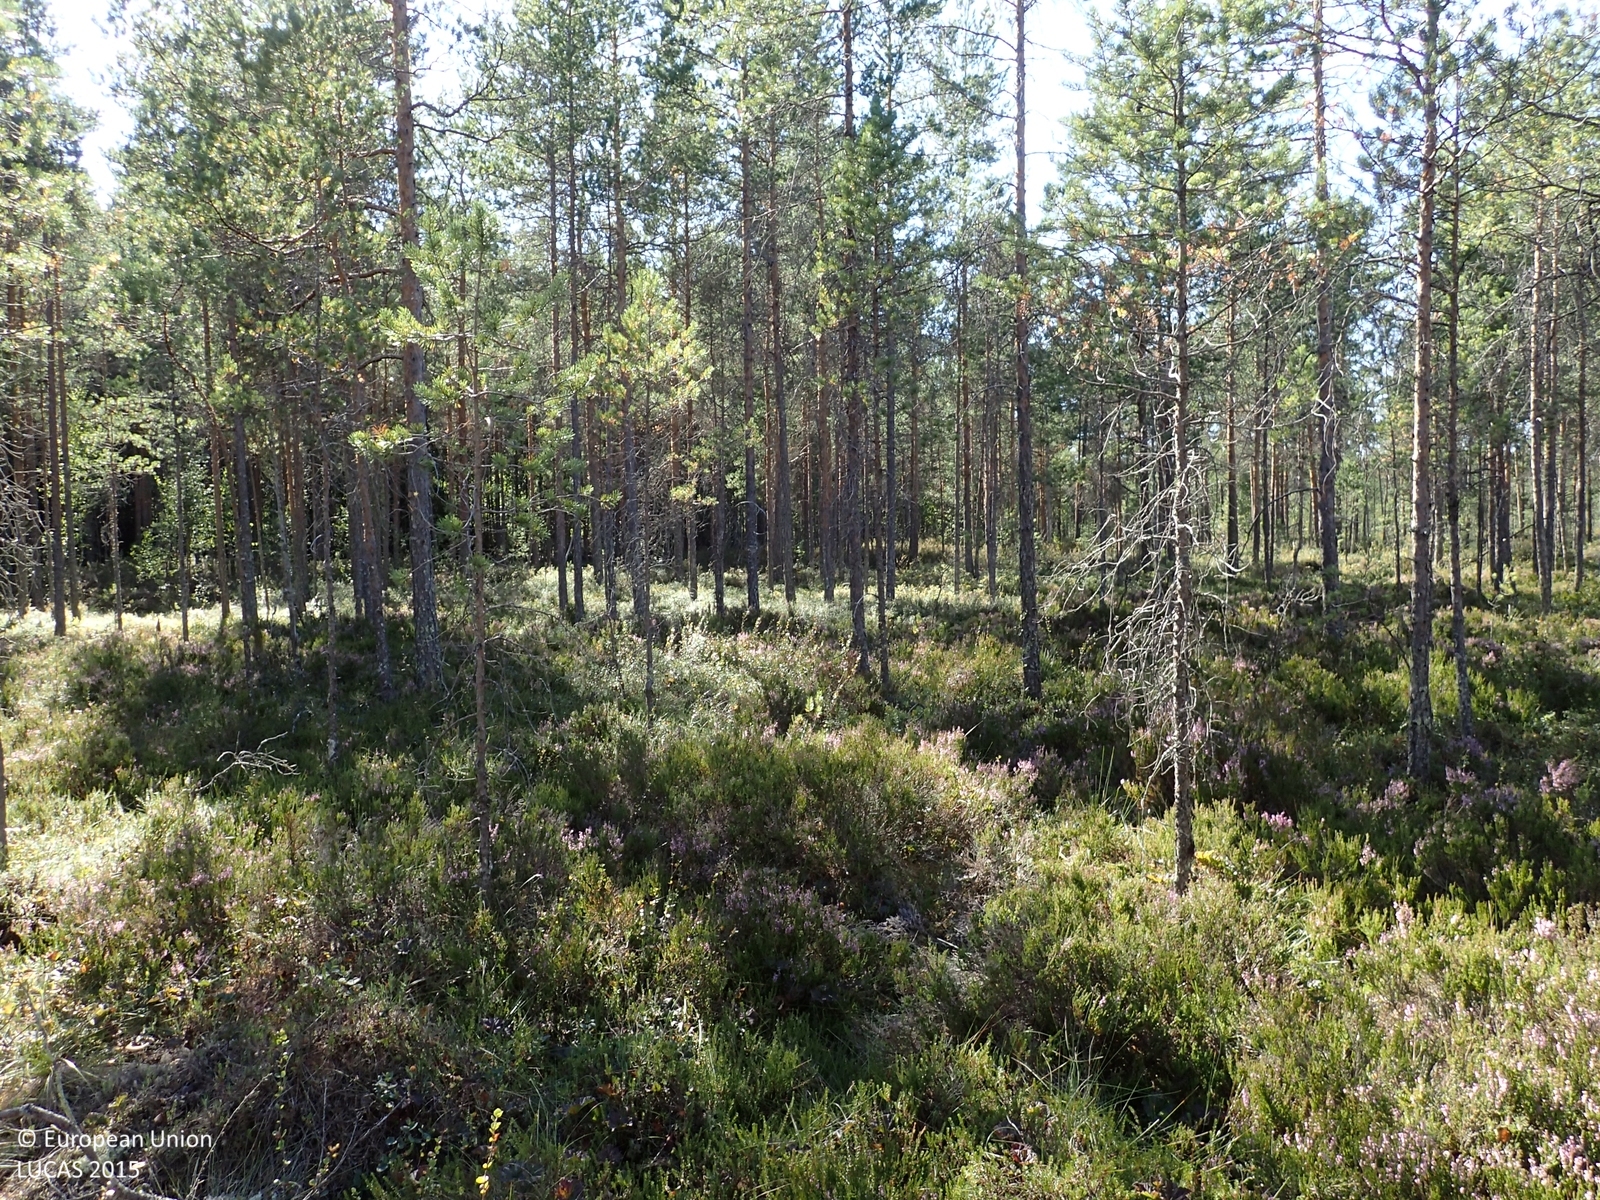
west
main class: Woodland
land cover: Pine dominated coniferous woodland
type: boreal forest
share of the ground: 25 - 50 %
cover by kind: shrubs 55 %, coniferous forest trees 45 %
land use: Forestry
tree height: < 5 m
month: August
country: FI
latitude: 62.6206
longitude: 22.7075
